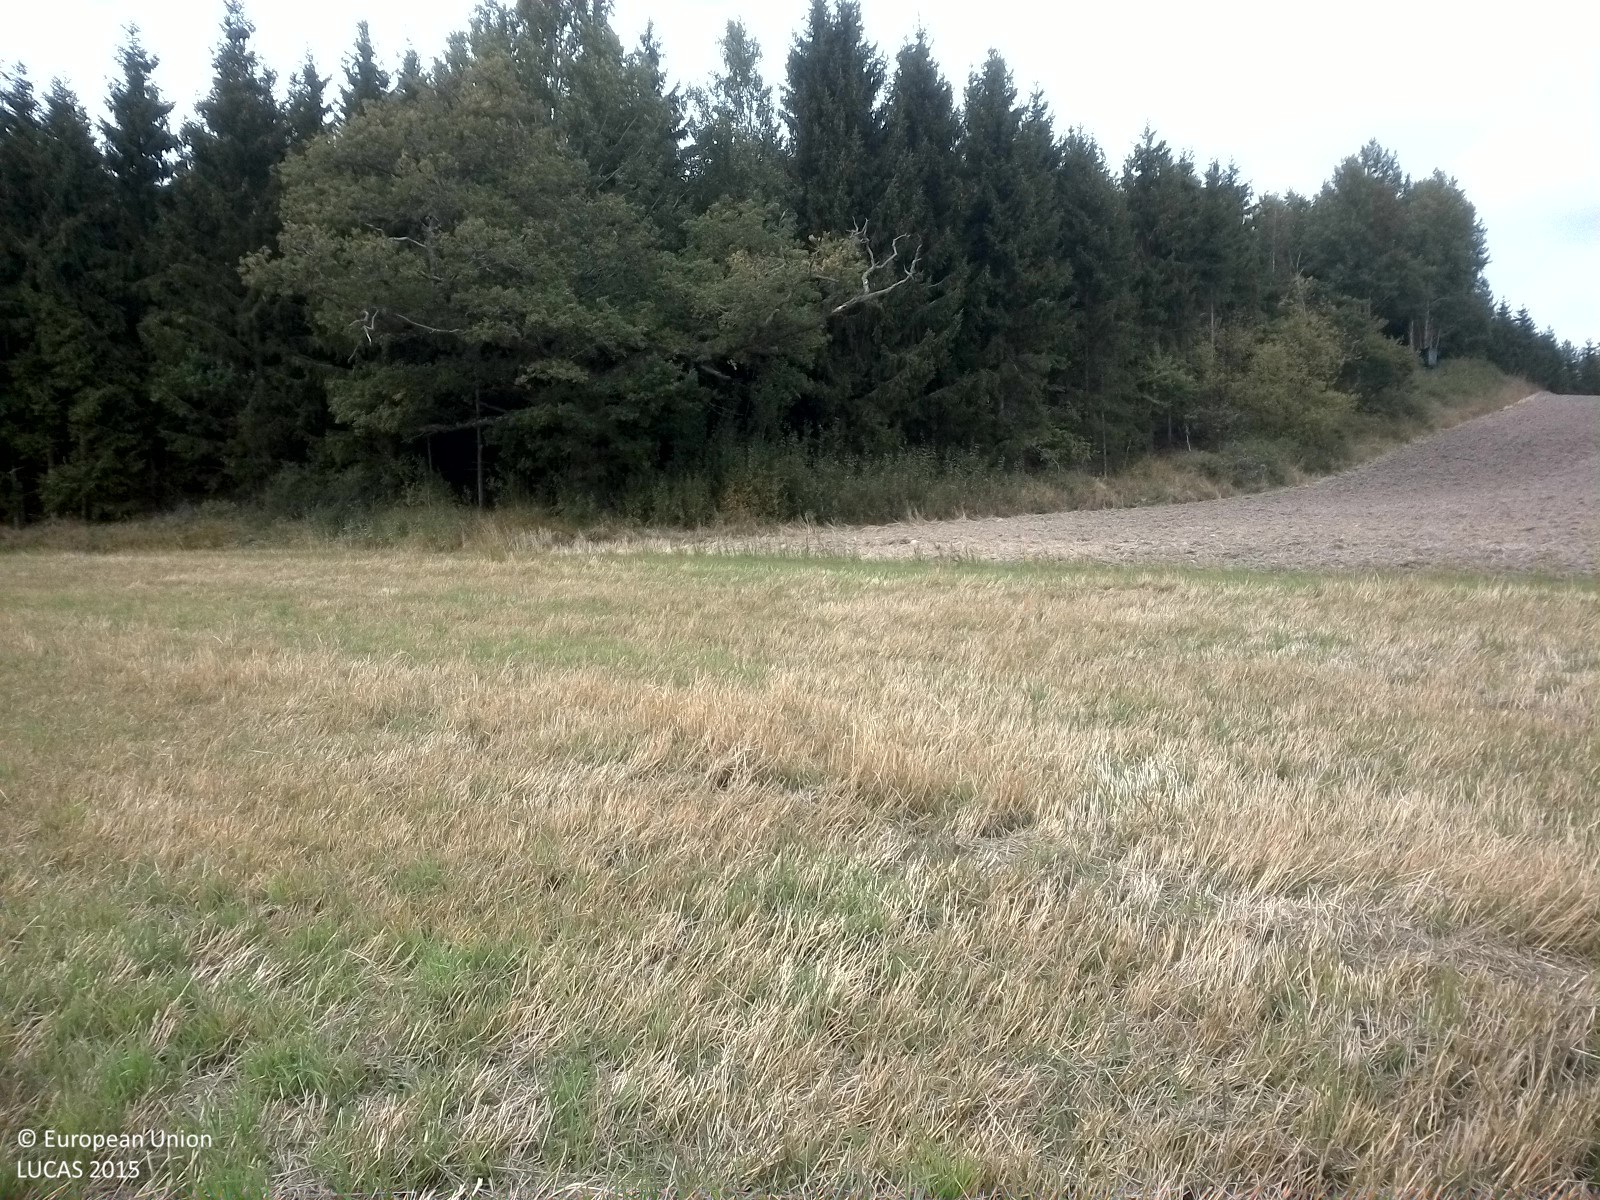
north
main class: Cropland
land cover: Temporary grasslands
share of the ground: > 75 %
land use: Agriculture (excluding fallow land and kitchen gardens)
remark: Harvested field
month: September
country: SE
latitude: 58.5884
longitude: 16.4466
